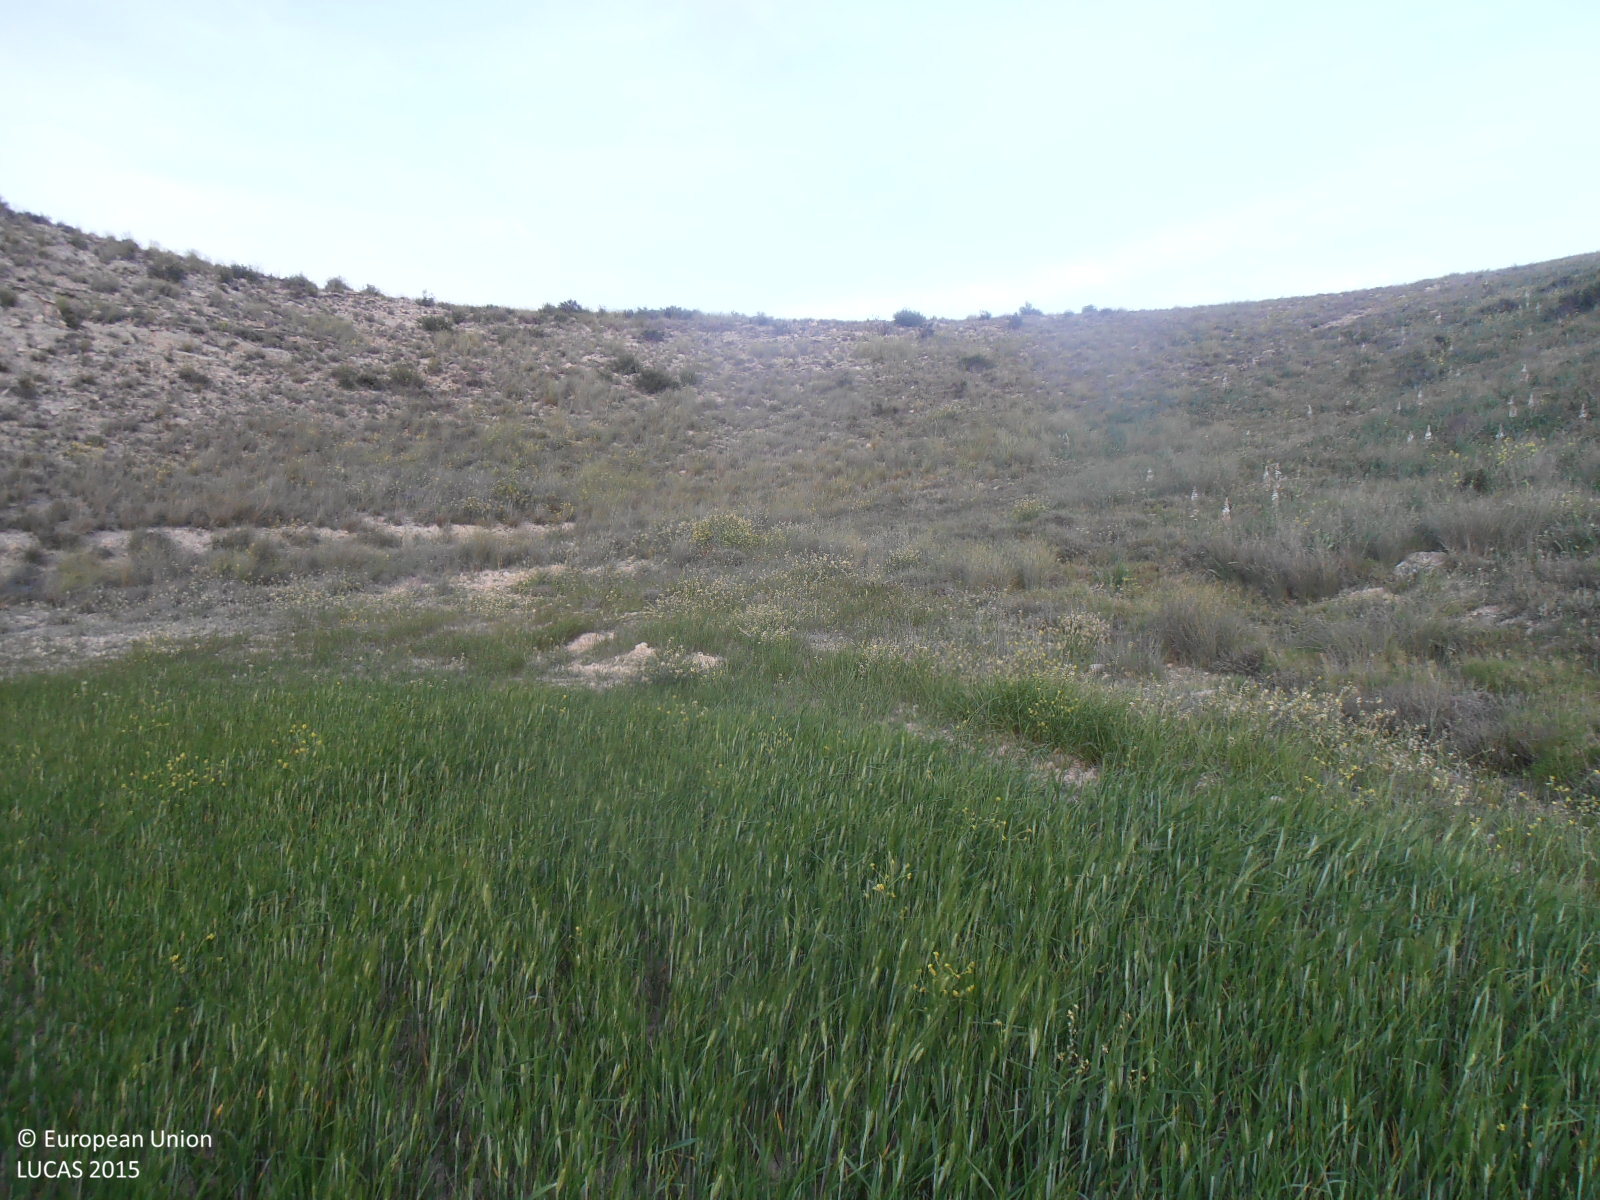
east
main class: Cropland
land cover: Durum wheat
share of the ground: > 75 %
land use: Agriculture (excluding fallow land and kitchen gardens)
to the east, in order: Durum wheat; Shrubland without tree cover; Other bare soil; Shrubland without tree cover
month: April
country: ES
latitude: 41.3729
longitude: -0.3817
